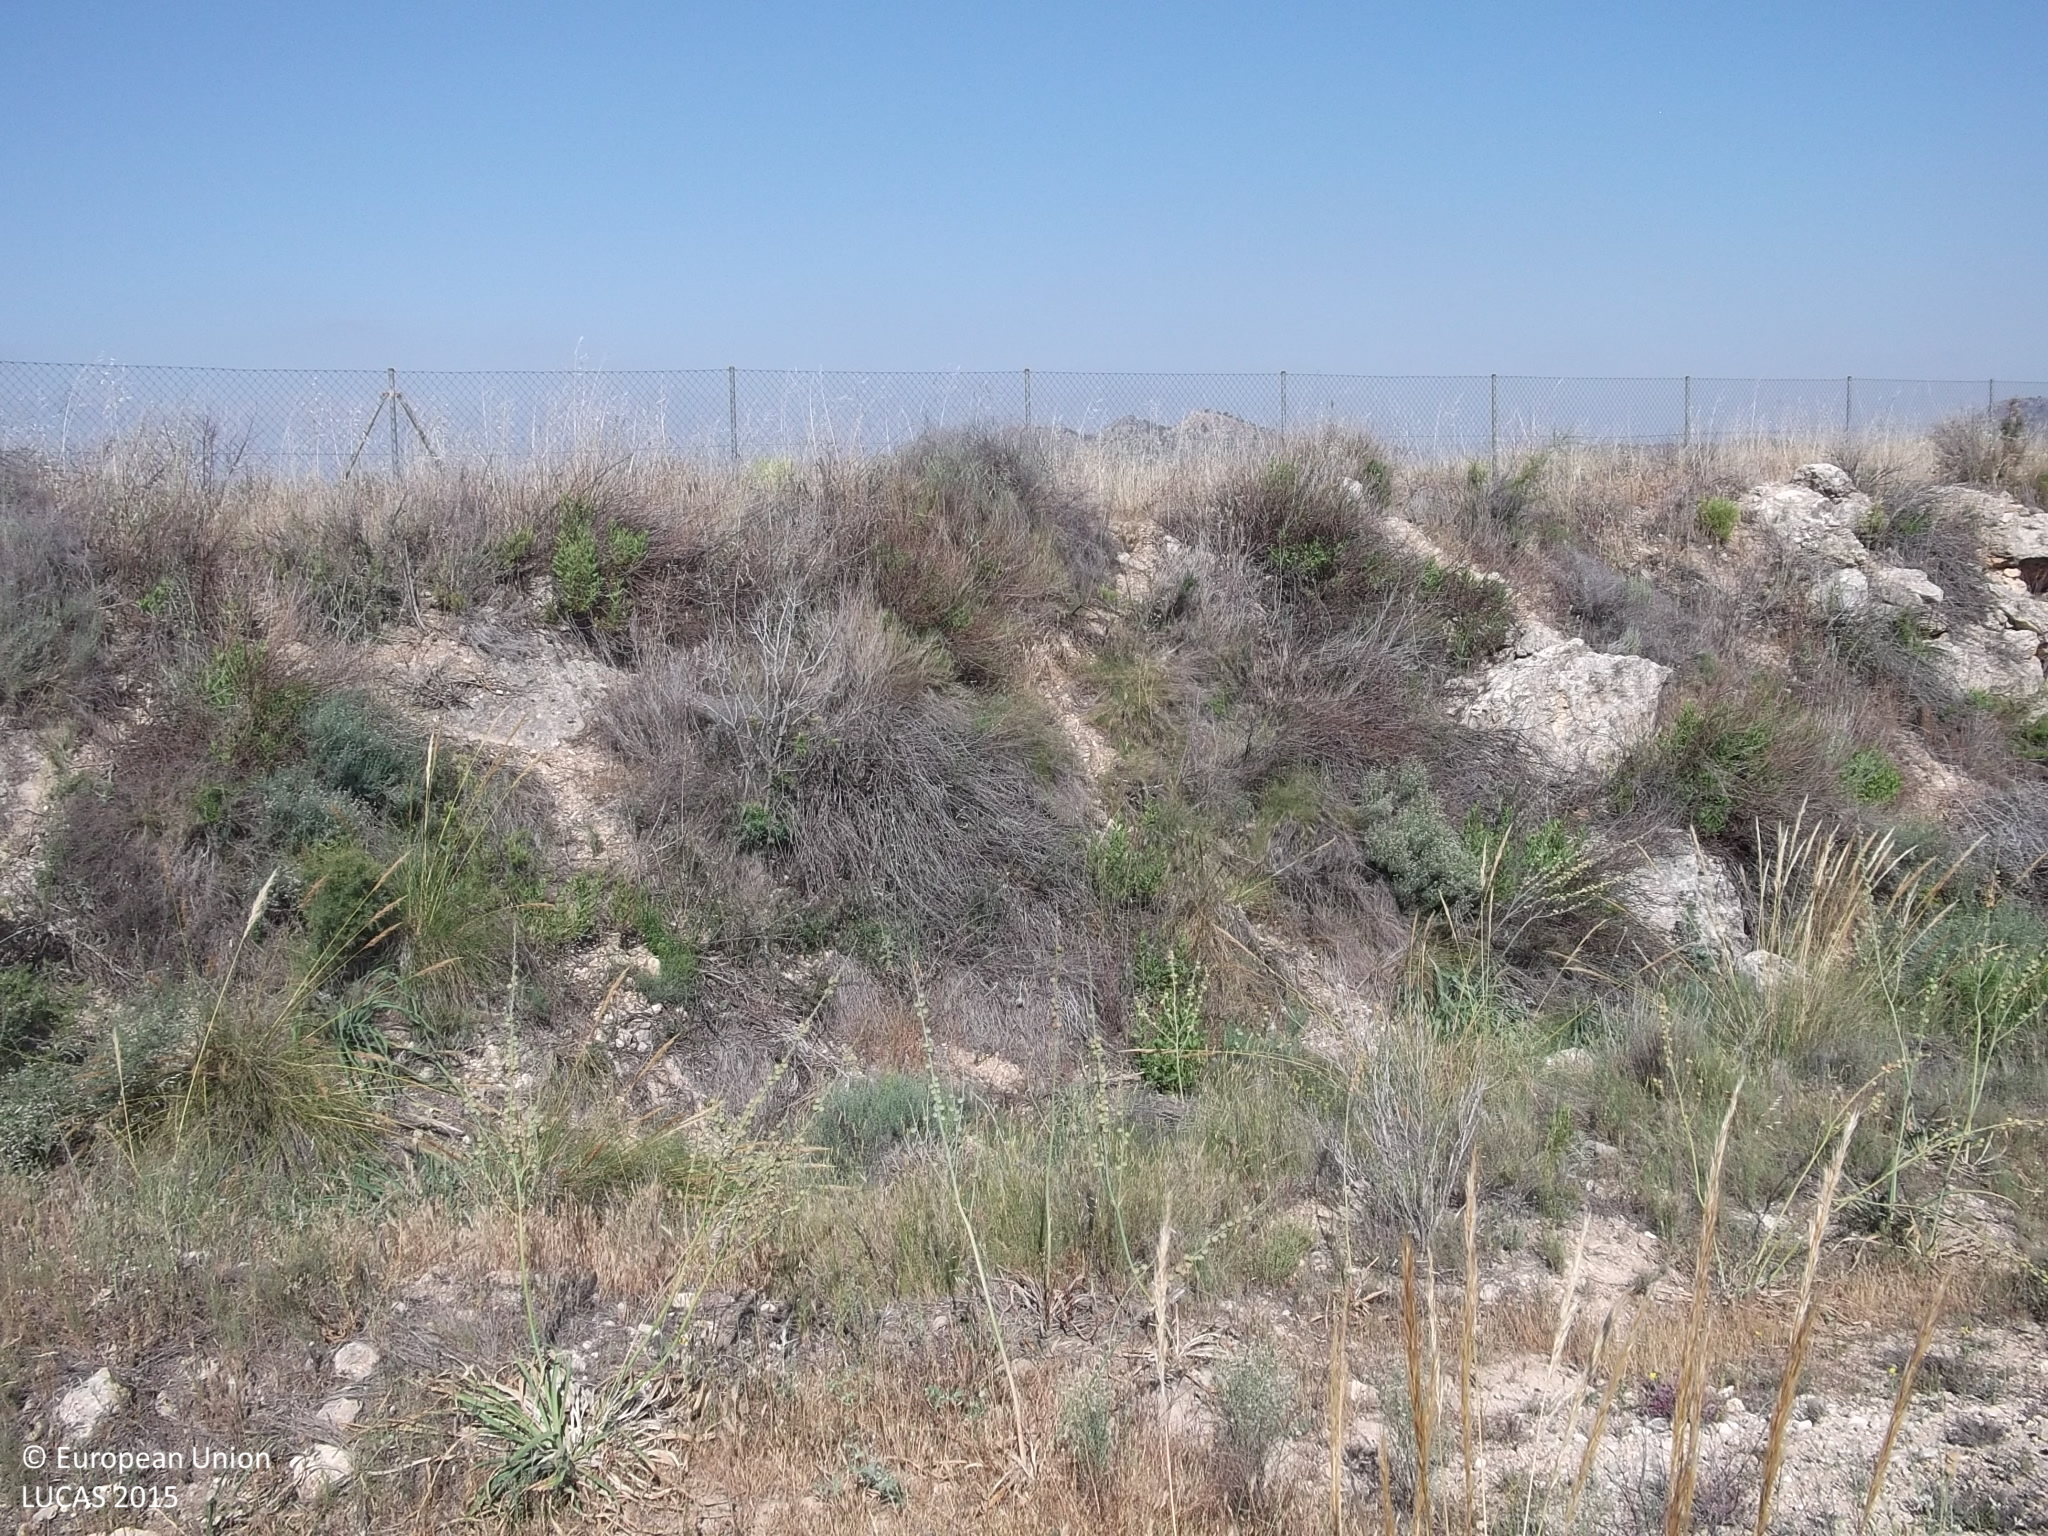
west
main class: Shrubland
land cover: Shrubland without tree cover
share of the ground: 50 - 75 %
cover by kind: shrubs 60 %, herbaceous plants 20 %, consolidated bare surface 20 %
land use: Semi-natural and natural areas not in use
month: May
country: ES
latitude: 38.4371
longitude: -1.5050
